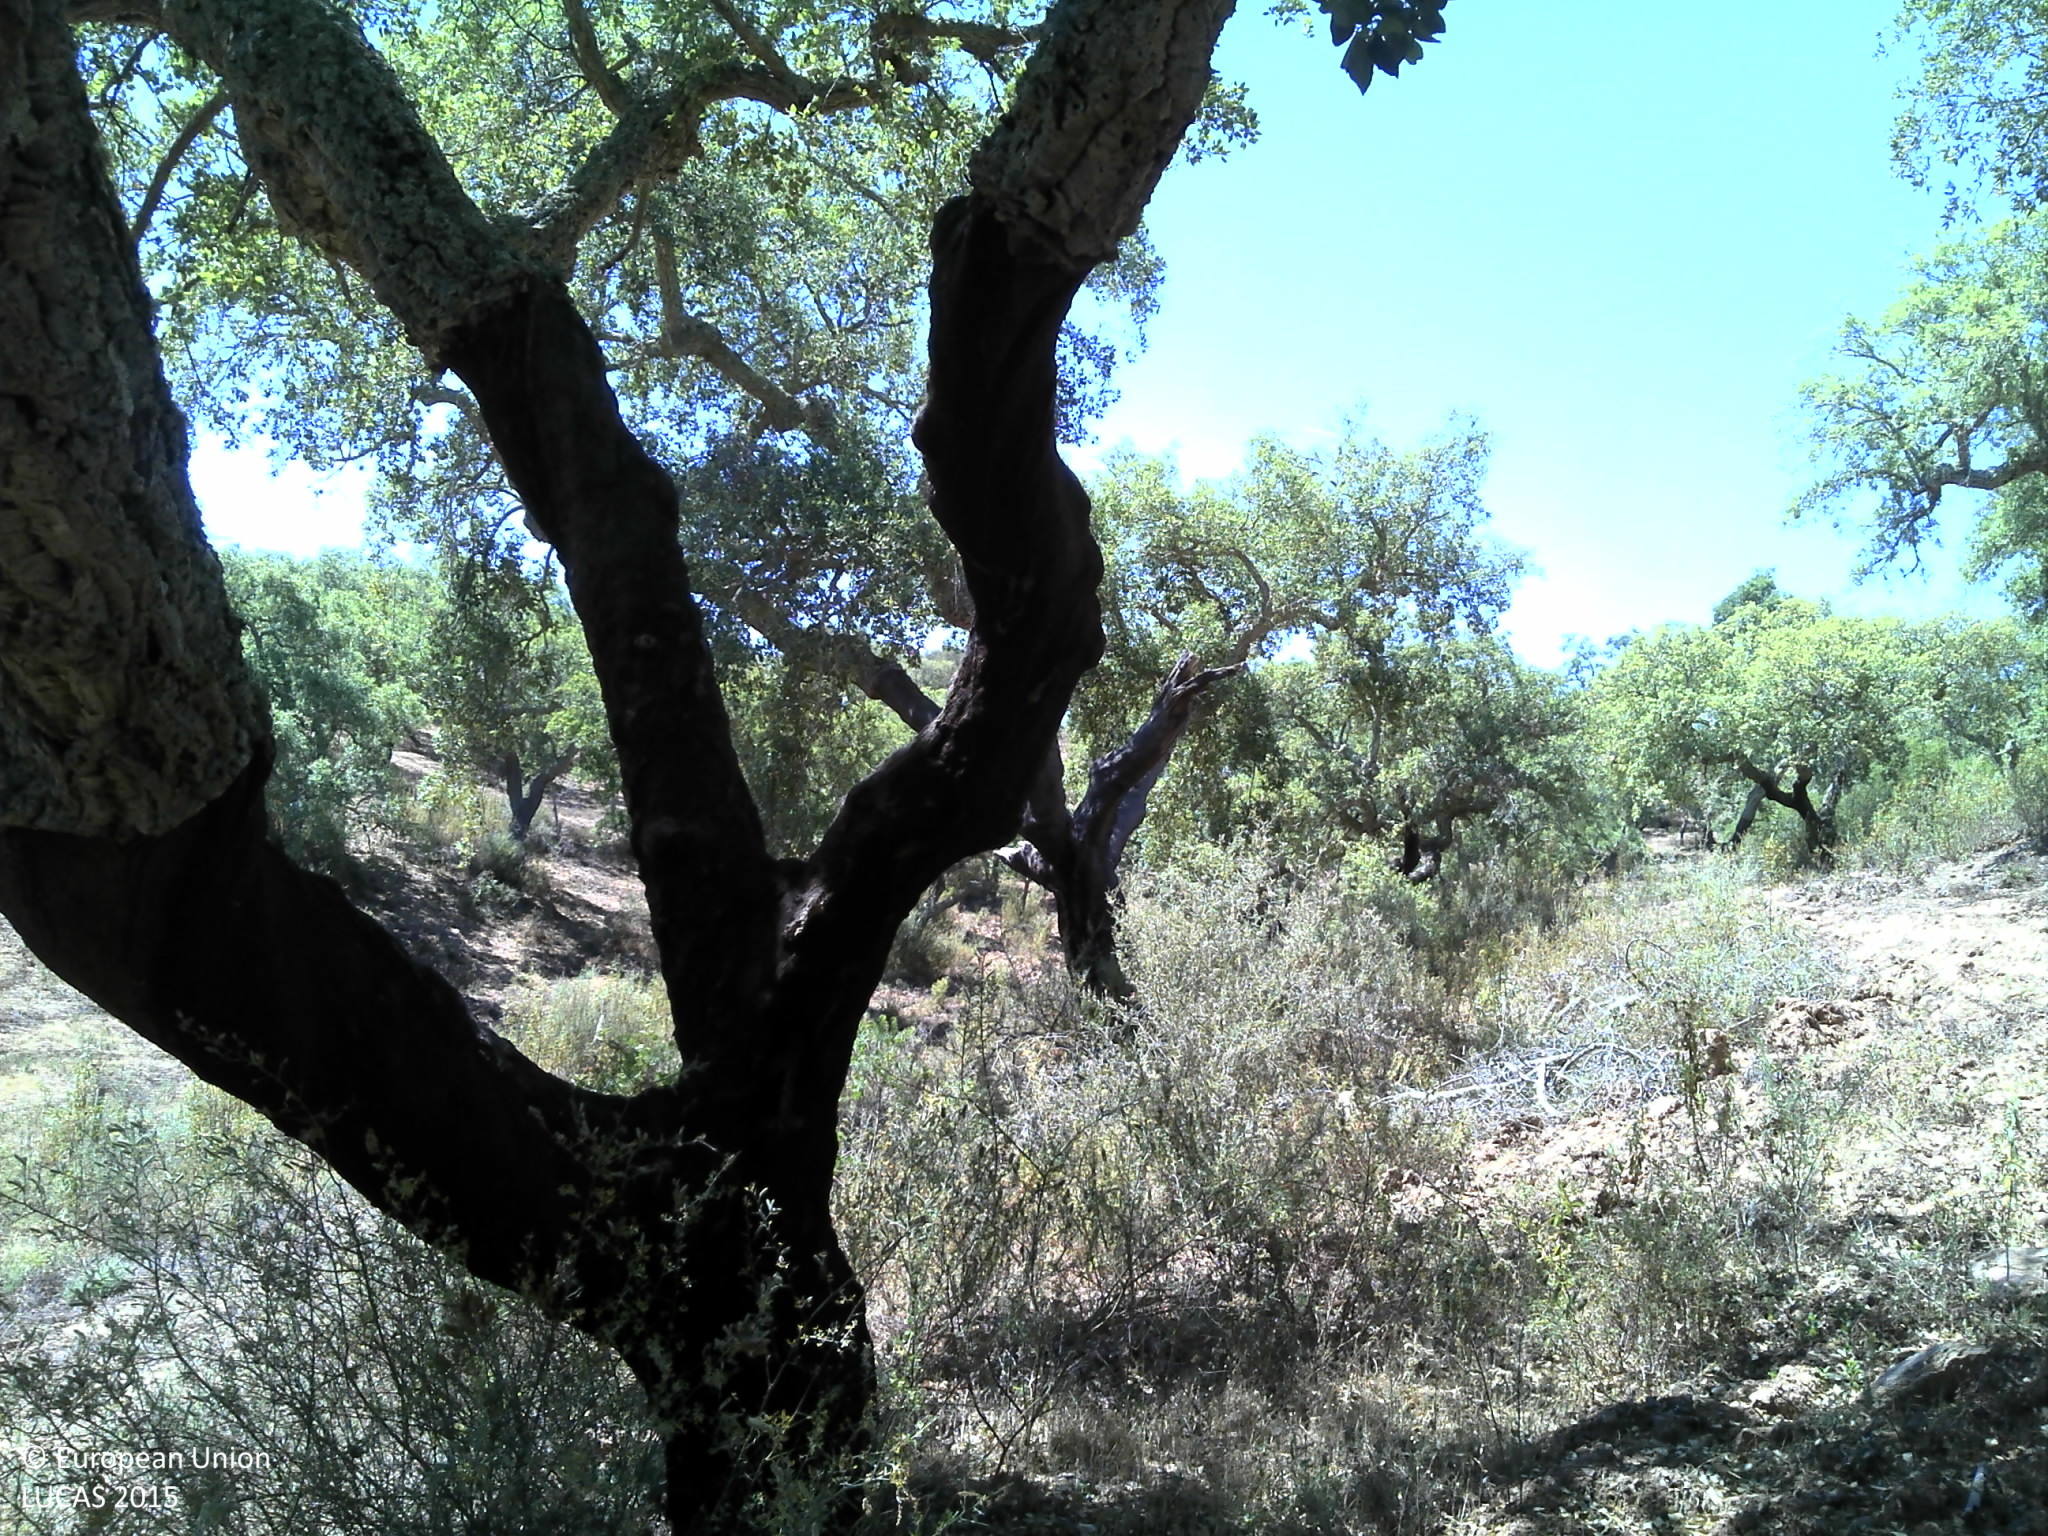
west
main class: Woodland
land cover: Broadleaved woodland
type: broadleaved evergreen forest
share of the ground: 25 - 50 %
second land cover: Grassland without tree/shrub cover
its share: 10 - 25 %
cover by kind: broadleaved forest trees 50 %, unconsolidated bare surface 35 %, herbaceous plants 15 %
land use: Forestry
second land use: Agriculture (excluding fallow land and kitchen gardens)
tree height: > 5 m
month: June
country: PT
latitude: 38.7851
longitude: -7.7332
